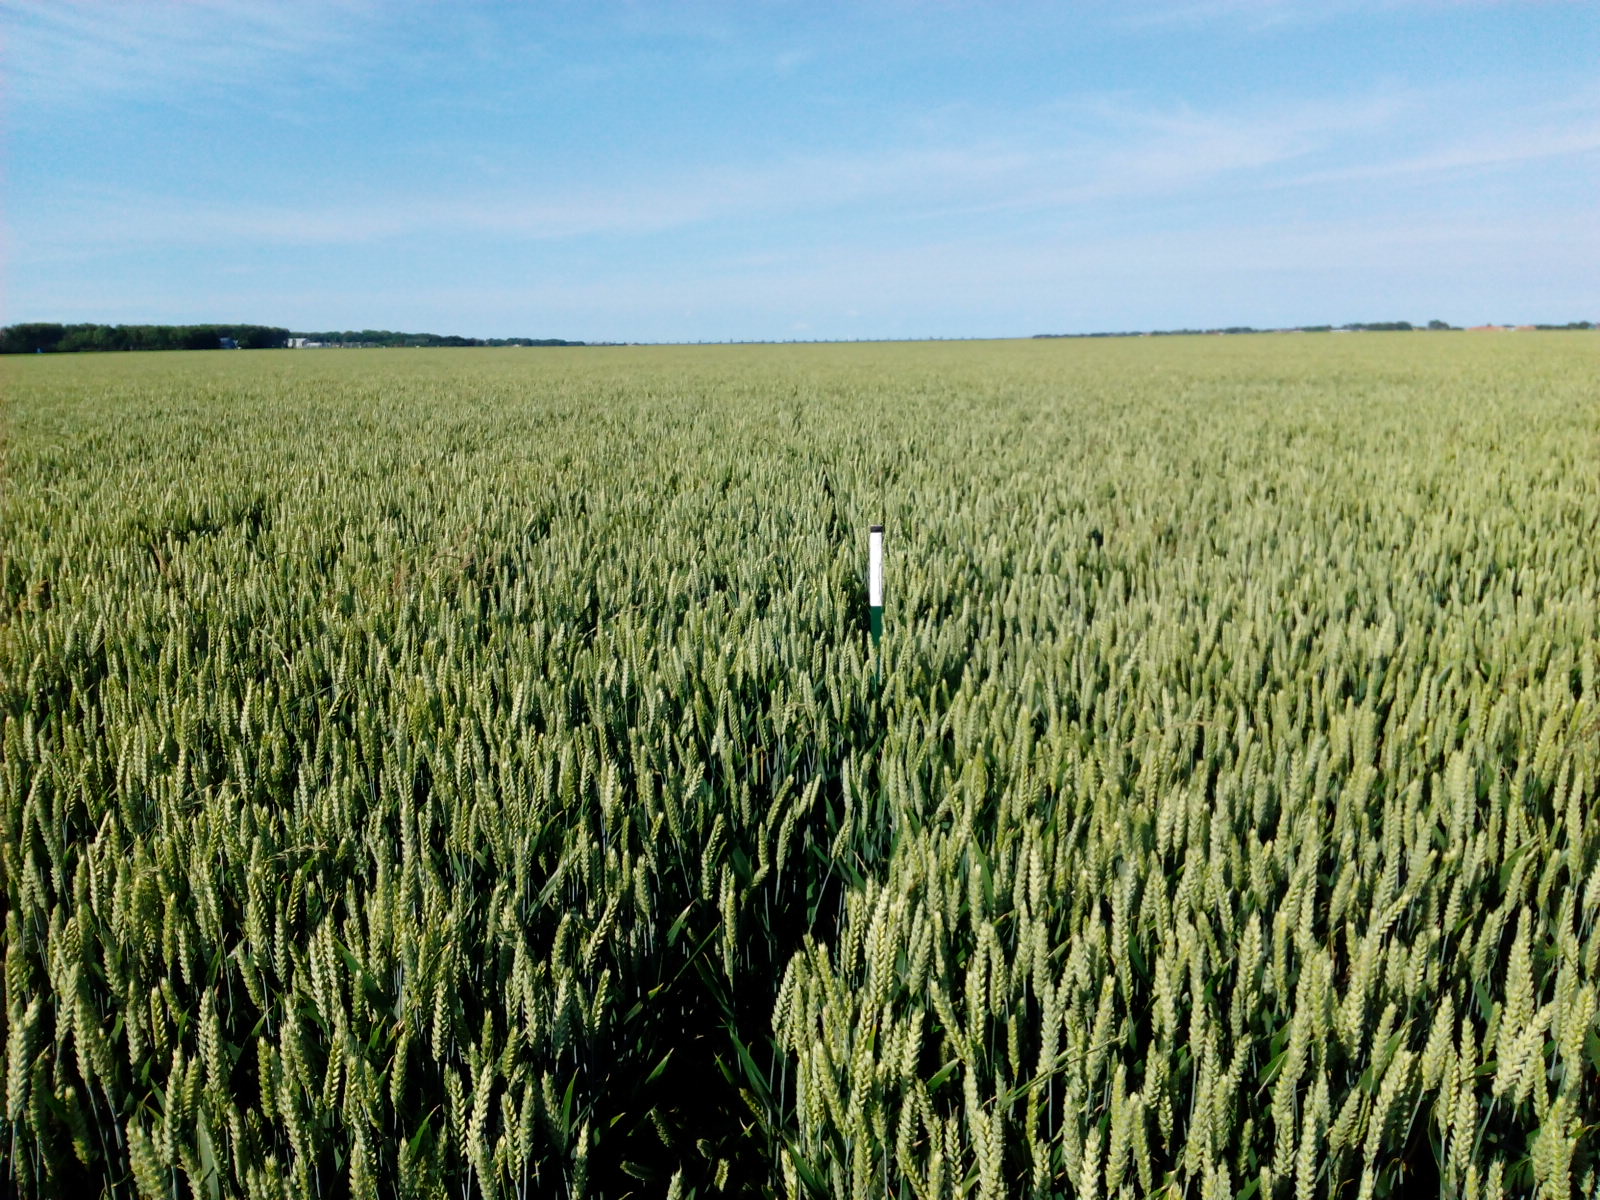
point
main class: Cropland
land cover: Common wheat
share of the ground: > 75 %
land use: Agriculture (excluding fallow land and kitchen gardens)
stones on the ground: < 10 %
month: June
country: NL
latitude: 52.5498
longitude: 5.6482
